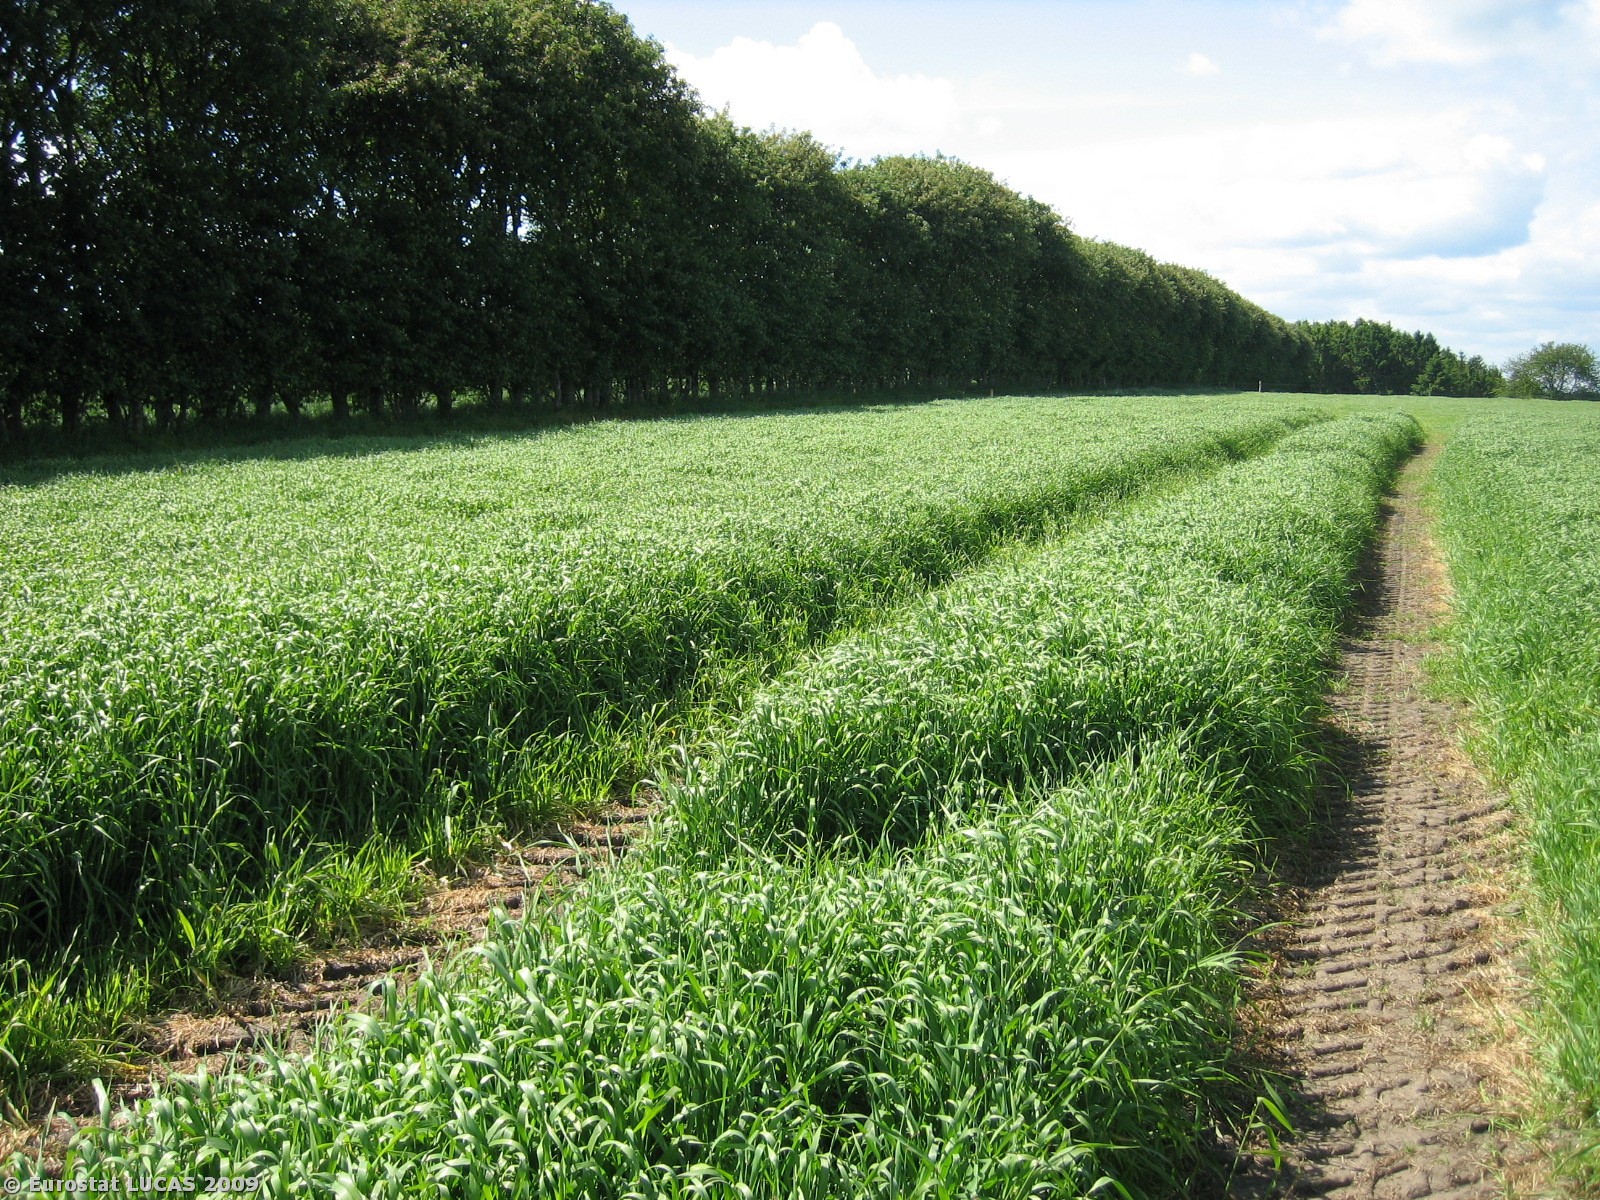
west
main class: Cropland
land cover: Barley
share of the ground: > 75 %
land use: Agriculture (excluding fallow land and kitchen gardens)
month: June
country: DK
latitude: 55.9897
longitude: 9.7278
